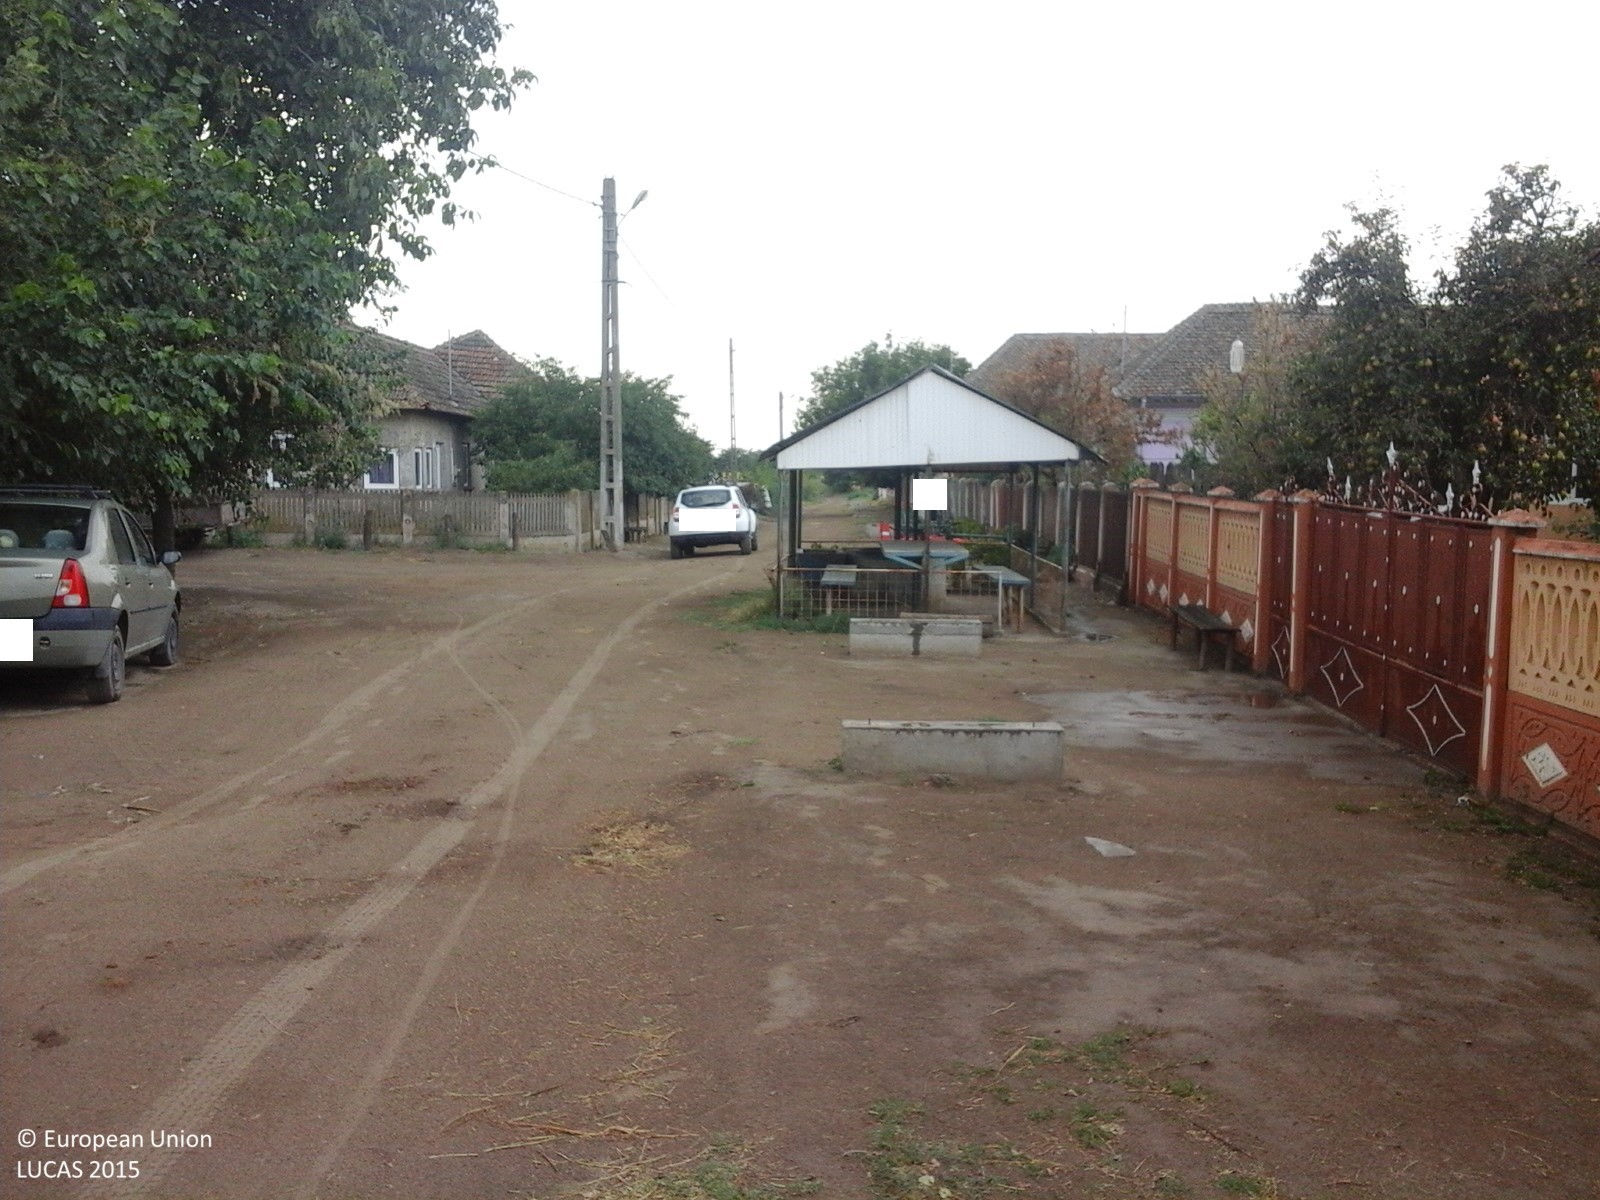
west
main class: Cropland
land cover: Other leguminous and mixtures for fodder
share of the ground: > 75 %
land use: Kitchen garden
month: August
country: RO
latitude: 43.9263
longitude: 23.0324
